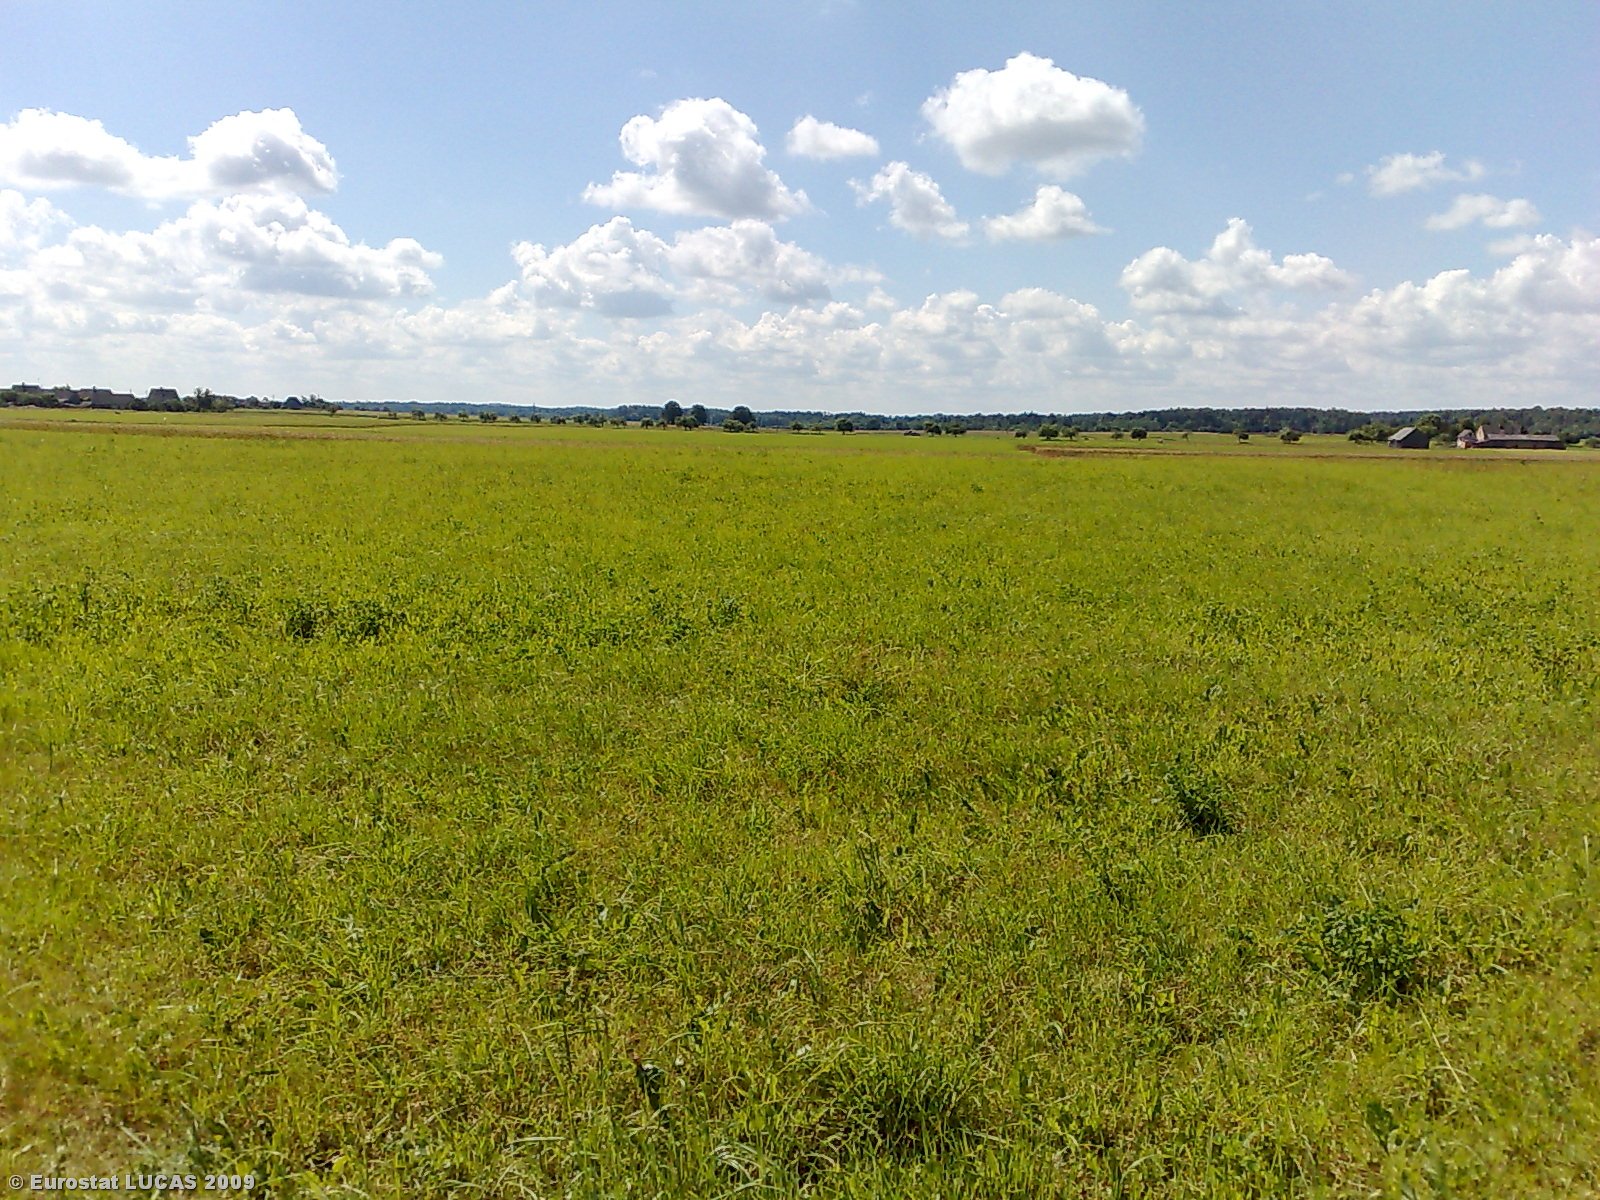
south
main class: Grassland
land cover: Grassland without tree/shrub cover
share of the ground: > 75 %
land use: Agriculture (excluding fallow land and kitchen gardens)
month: July
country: LT
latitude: 55.9354
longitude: 22.8885
